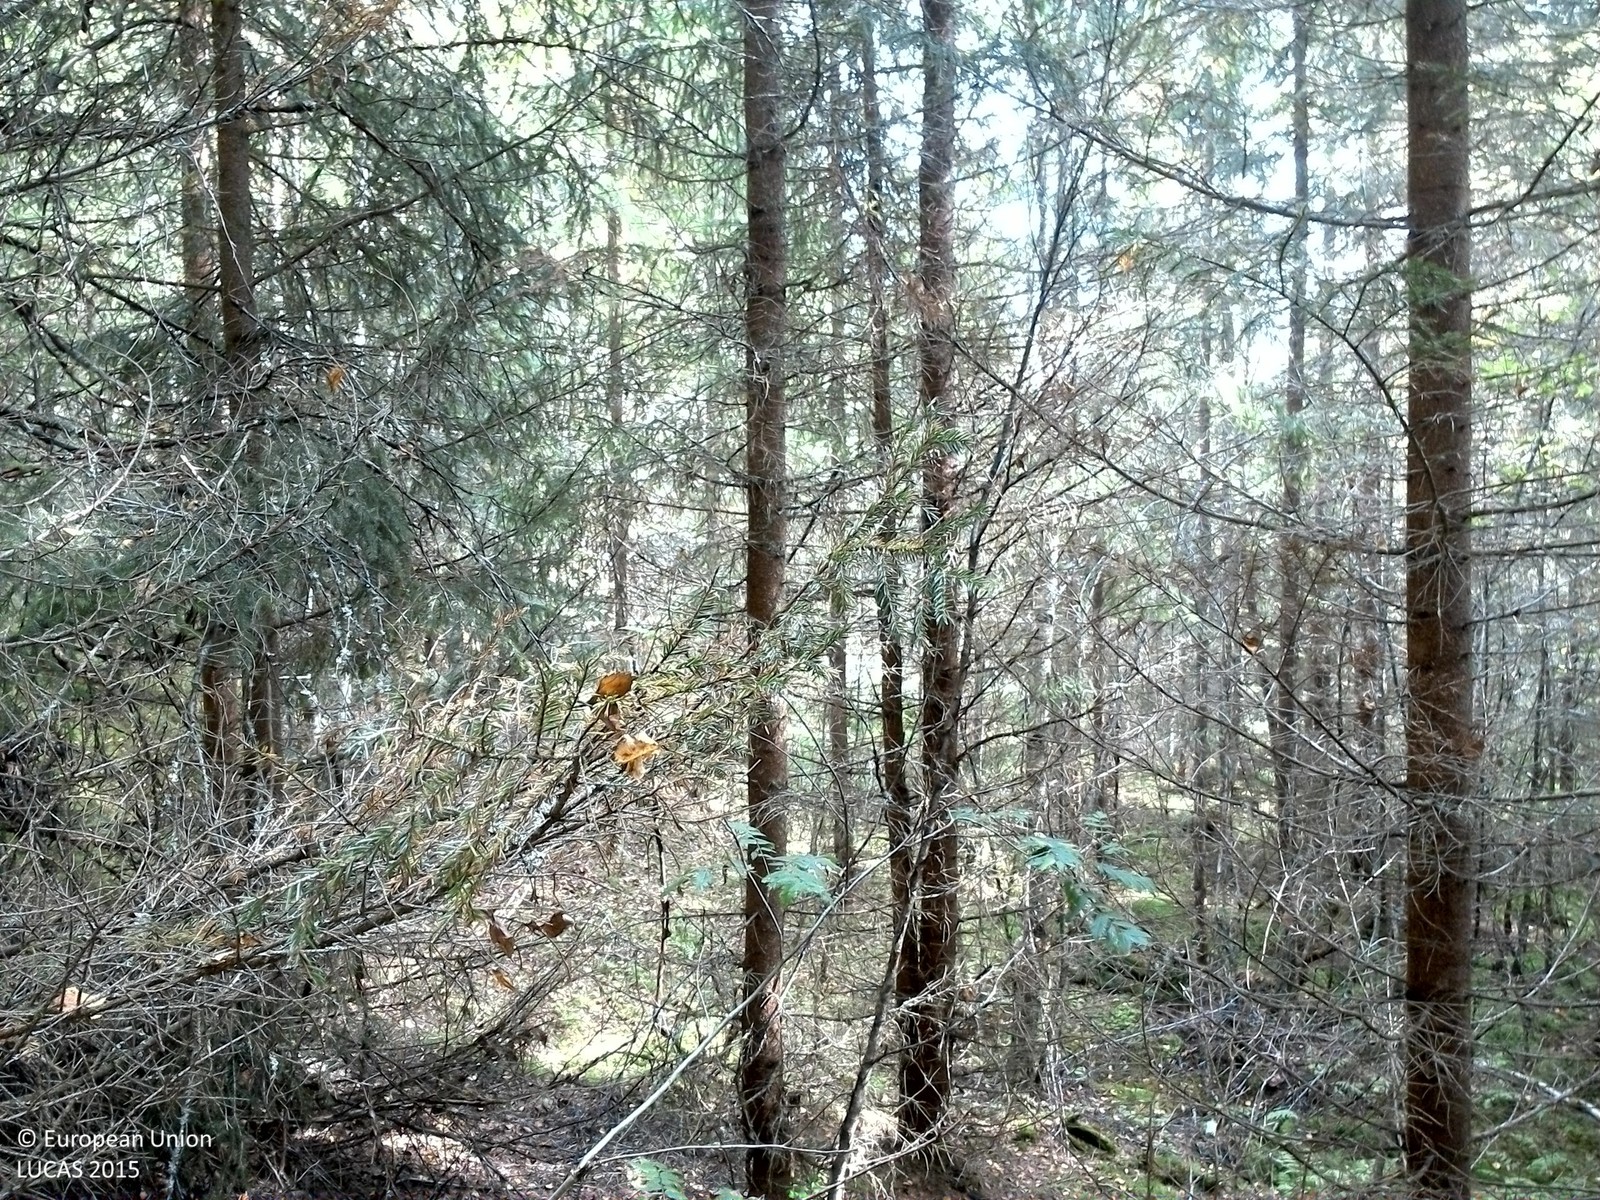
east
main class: Woodland
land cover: Spruce dominated coniferous woodland
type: boreal forest
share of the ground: 50 - 75 %
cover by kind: coniferous forest trees 60 %, lichens and mosses 20 %, broadleaved forest trees 10 %, shrubs 5 %, herbaceous plants 5 %
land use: Forestry
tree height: > 5 m
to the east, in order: Spruce dominated coniferous woodland; Spruce dominated mixed woodland; Tracks; Spruce dominated mixed woodland; Broadleaved woodland; Inland fresh running water; Broadleaved woodland; Spruce dominated mixed woodland; Rocks and stones; Inland fresh running water
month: September
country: SE
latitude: 59.9566
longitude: 13.5185
